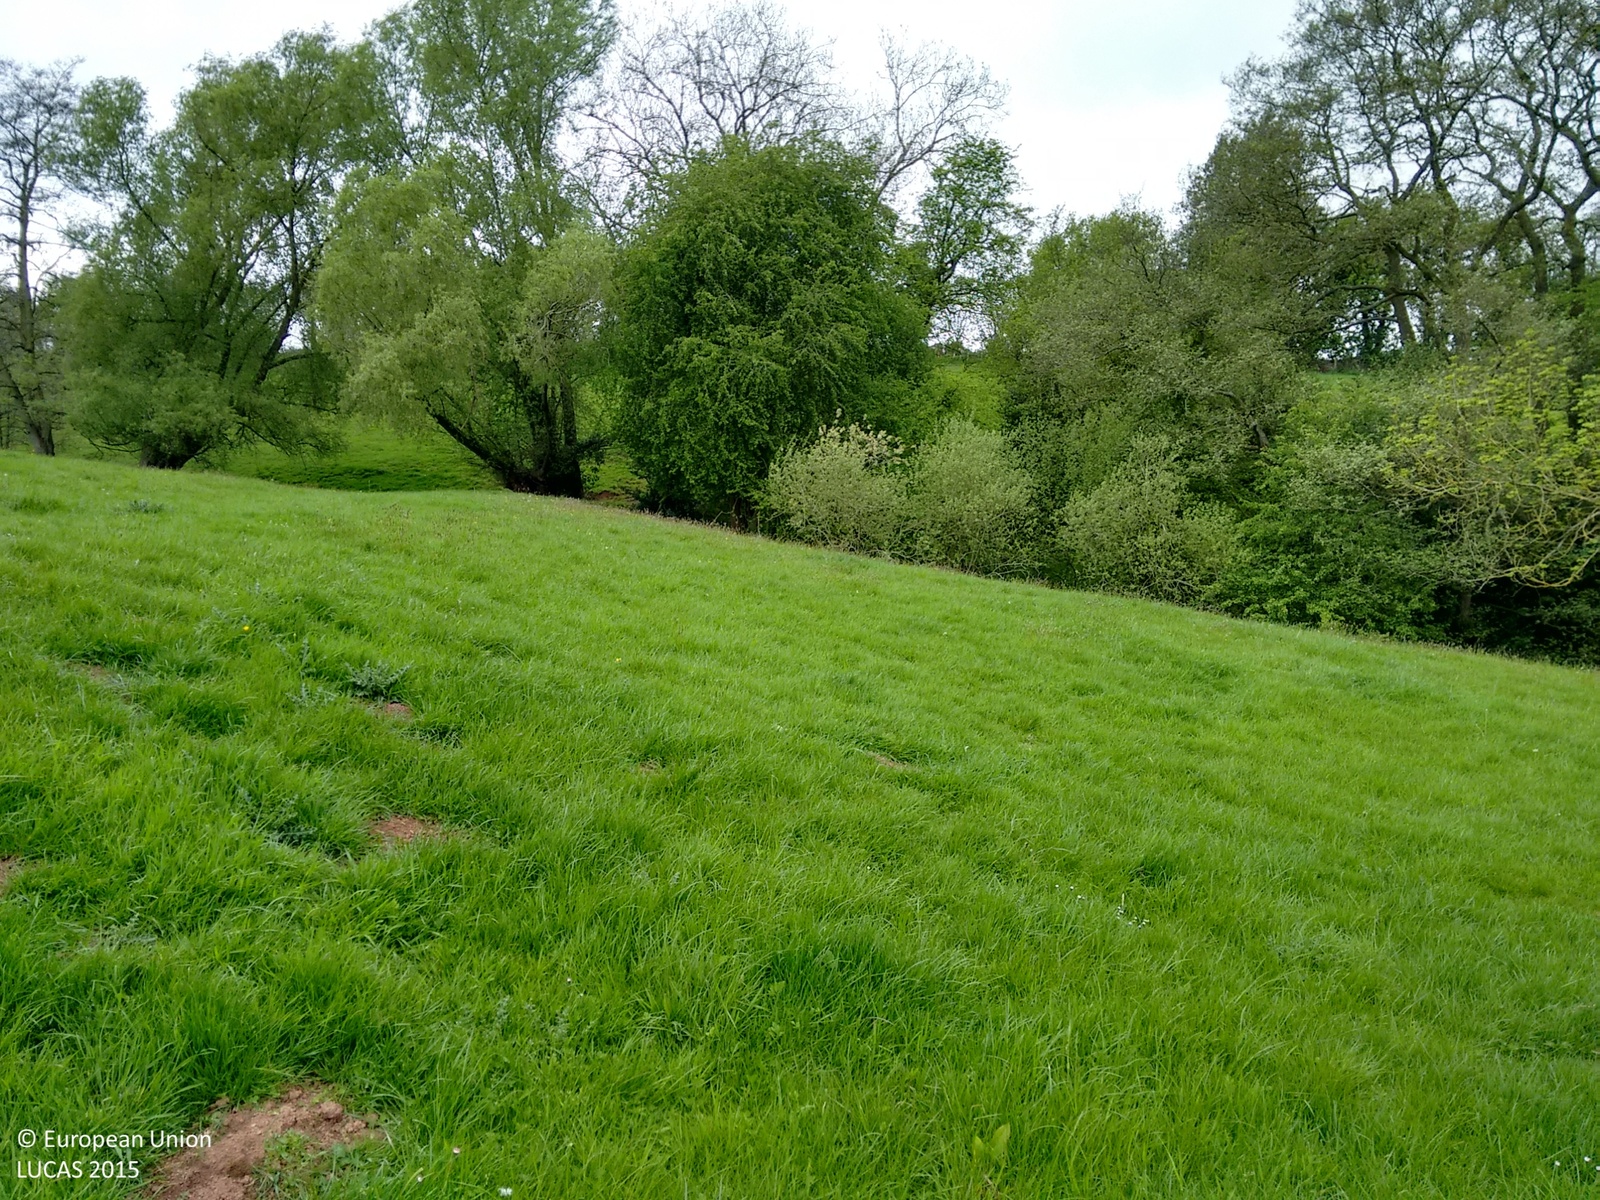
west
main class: Grassland
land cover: Grassland without tree/shrub cover
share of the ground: > 75 %
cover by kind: herbaceous plants 100 %
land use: Agriculture (excluding fallow land and kitchen gardens)
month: May
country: GB
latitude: 52.2974
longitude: -2.4860
